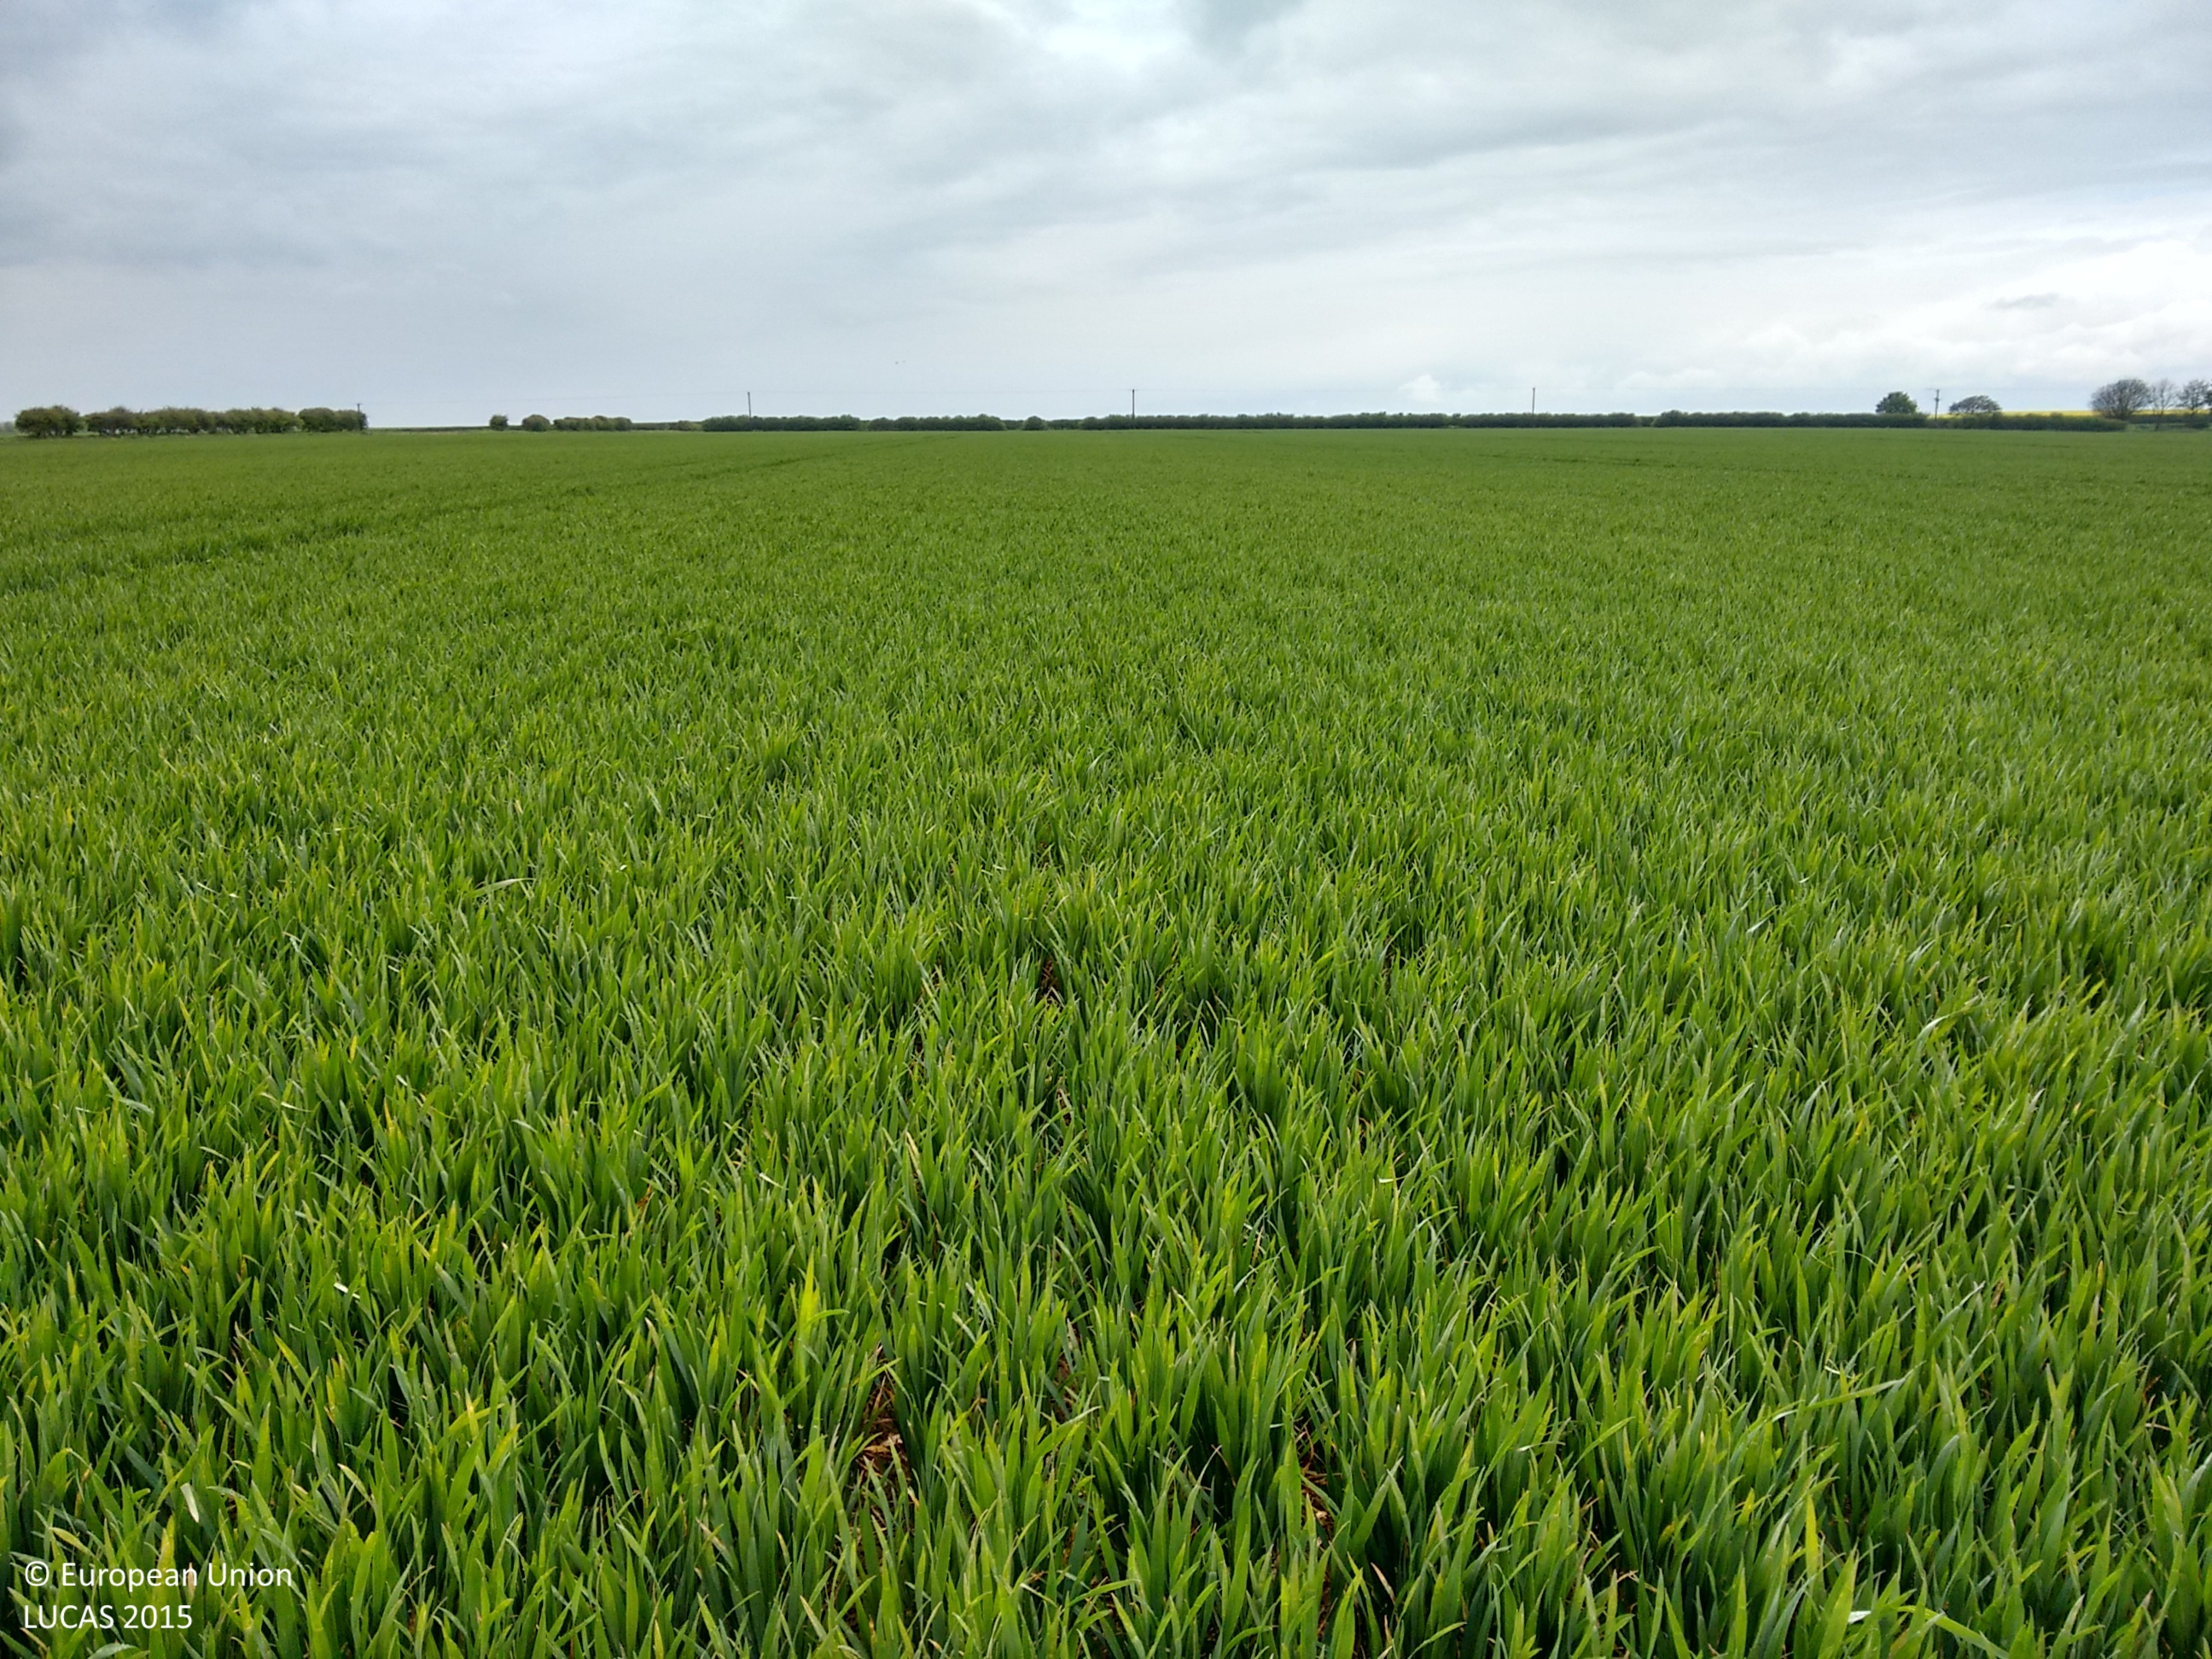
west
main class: Cropland
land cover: Barley
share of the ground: > 75 %
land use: Agriculture (excluding fallow land and kitchen gardens)
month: May
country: GB
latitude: 53.3910
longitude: -0.1533
